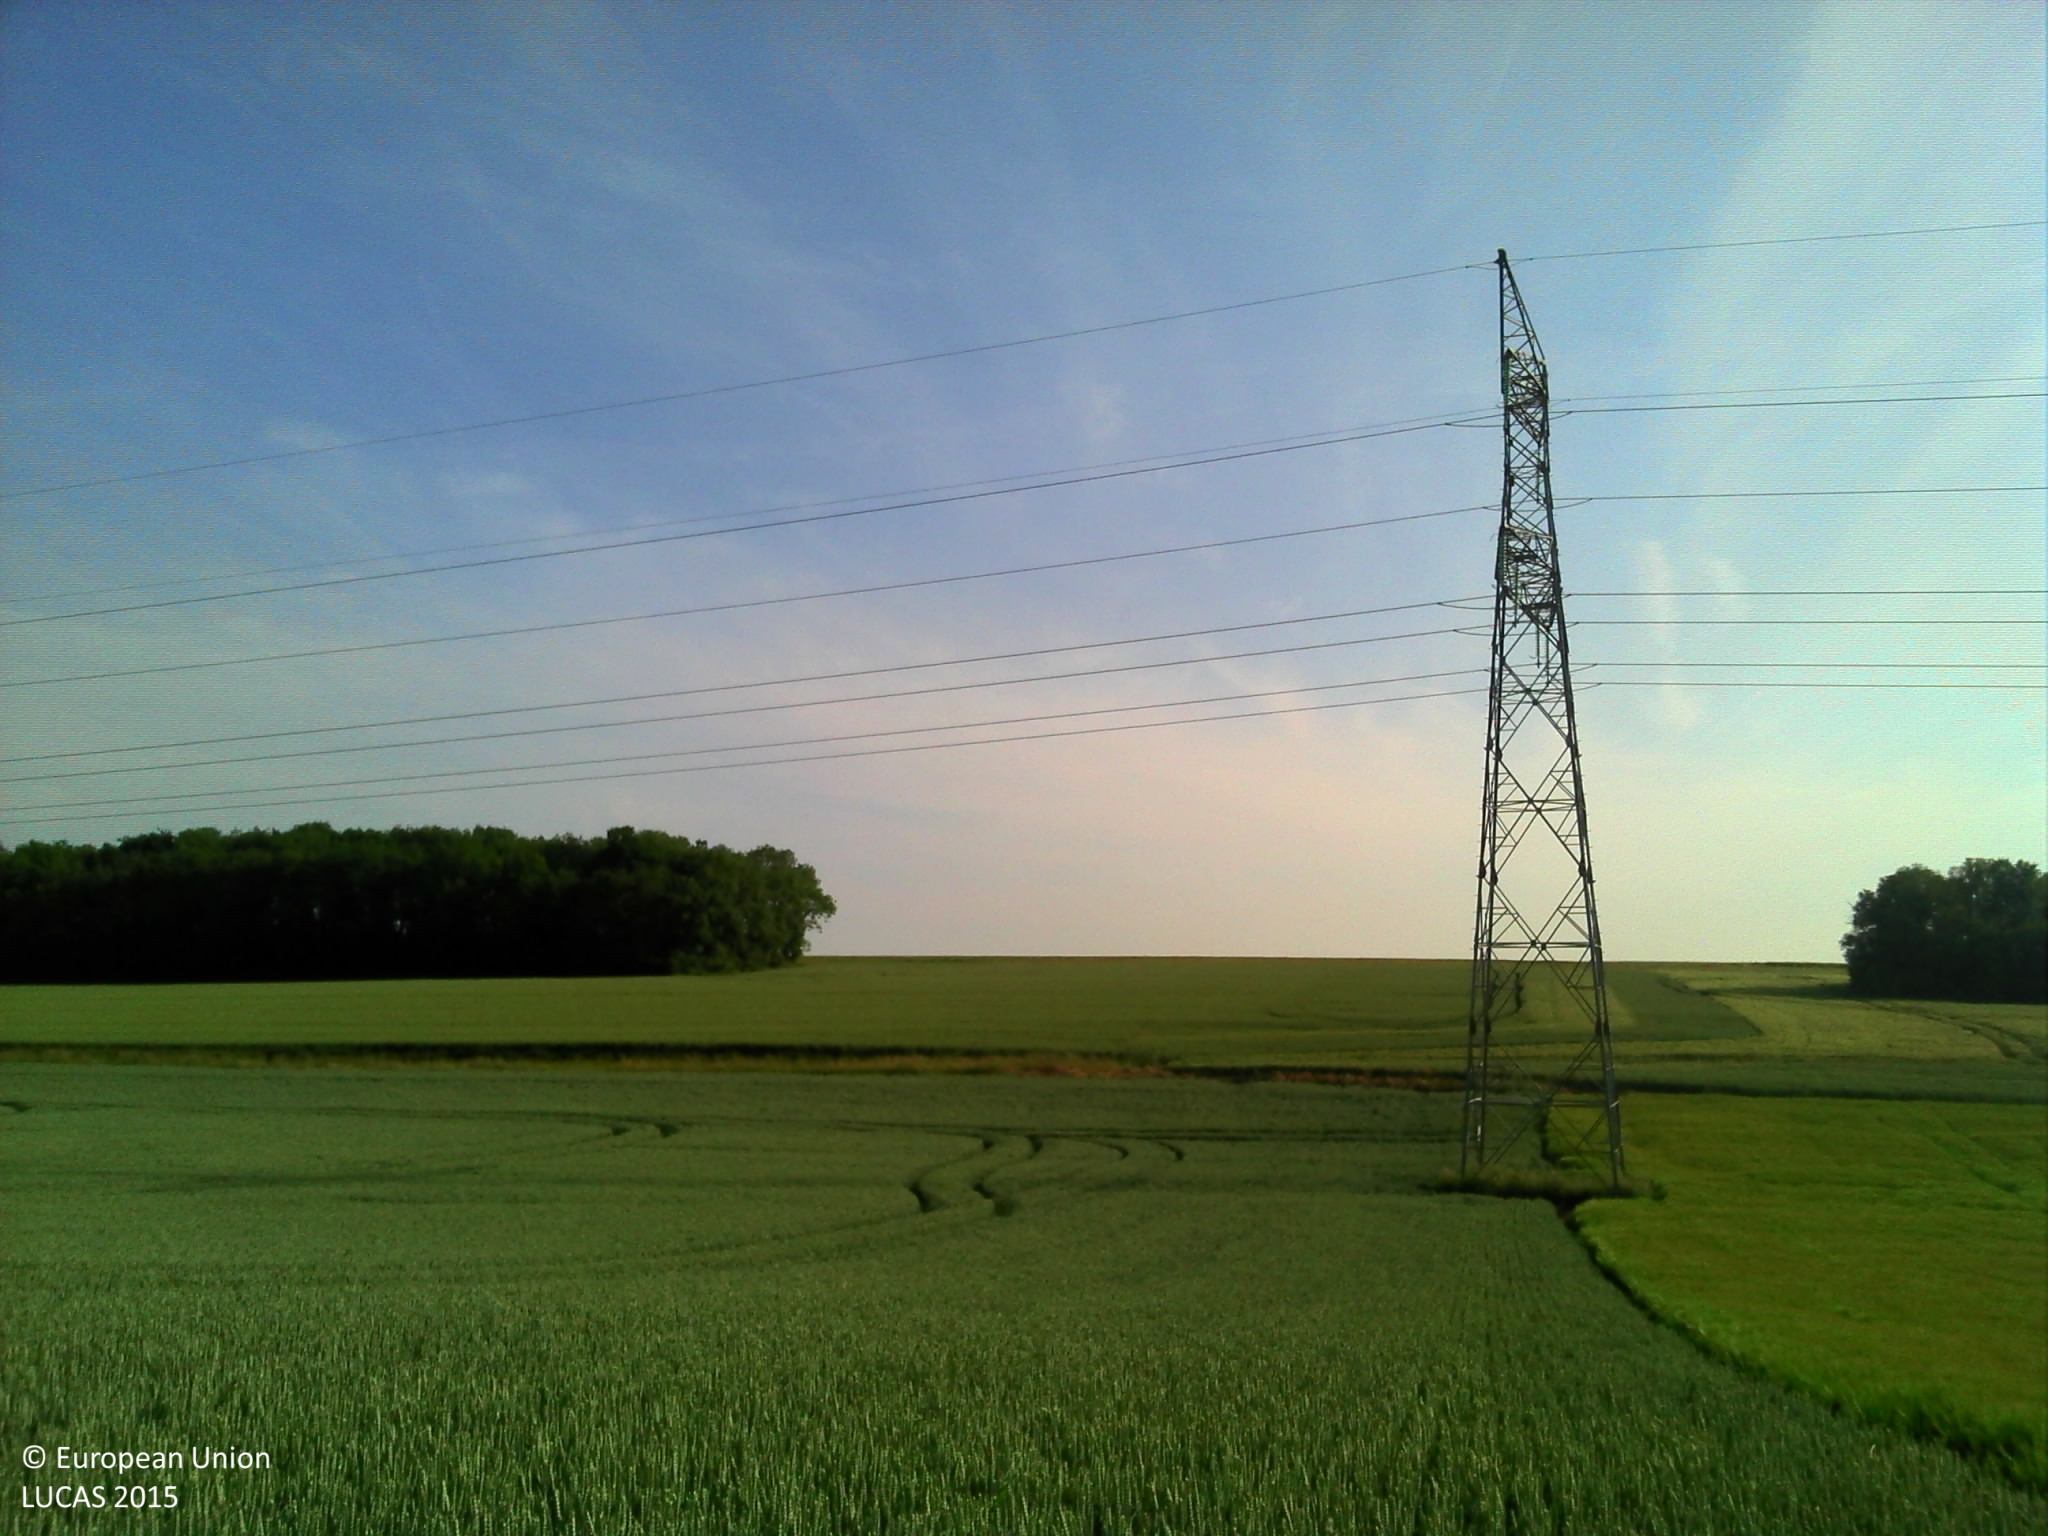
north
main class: Cropland
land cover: Common wheat
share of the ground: > 75 %
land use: Agriculture (excluding fallow land and kitchen gardens)
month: June
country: FR
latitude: 49.4690
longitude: 2.5228
